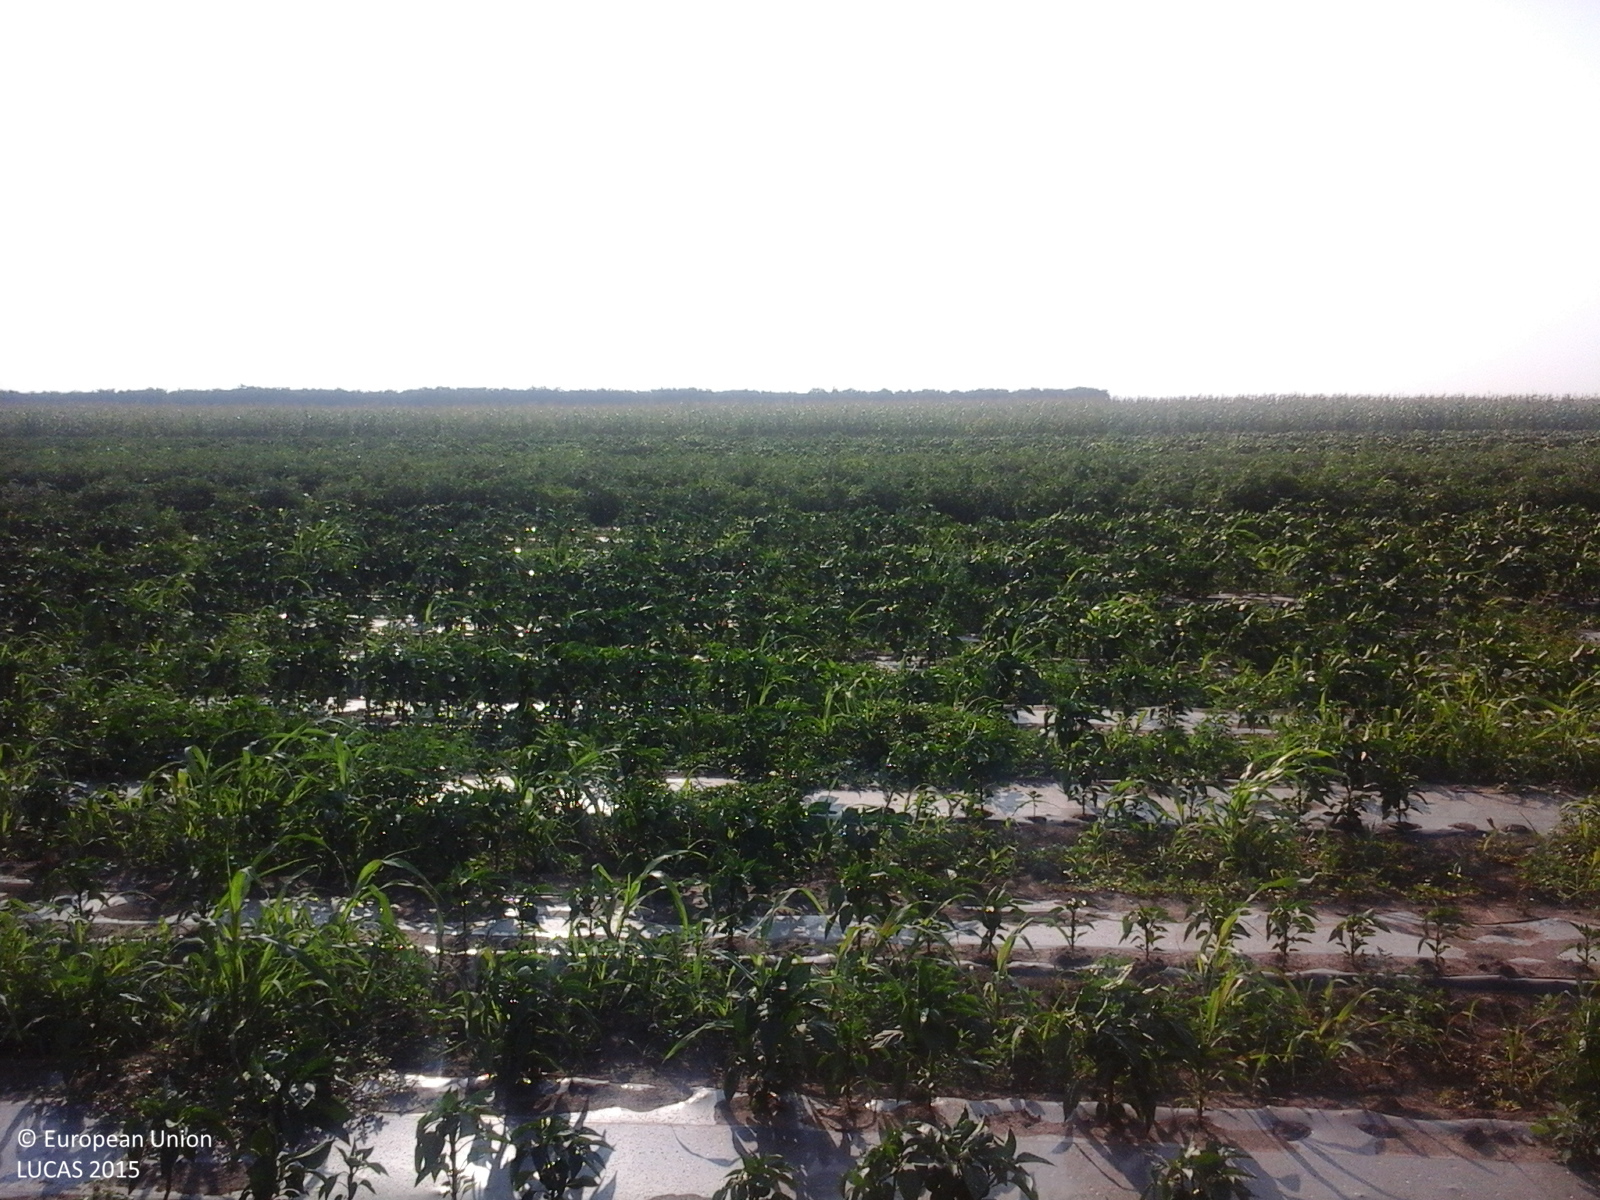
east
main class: Cropland
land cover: Other fresh vegetables
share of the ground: > 75 %
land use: Agriculture (excluding fallow land and kitchen gardens)
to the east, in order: Other fresh vegetables; Tomatoes; Other fresh vegetables; Maize; Common wheat; Sunflower
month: July
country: RO
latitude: 44.6114
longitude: 27.2102
